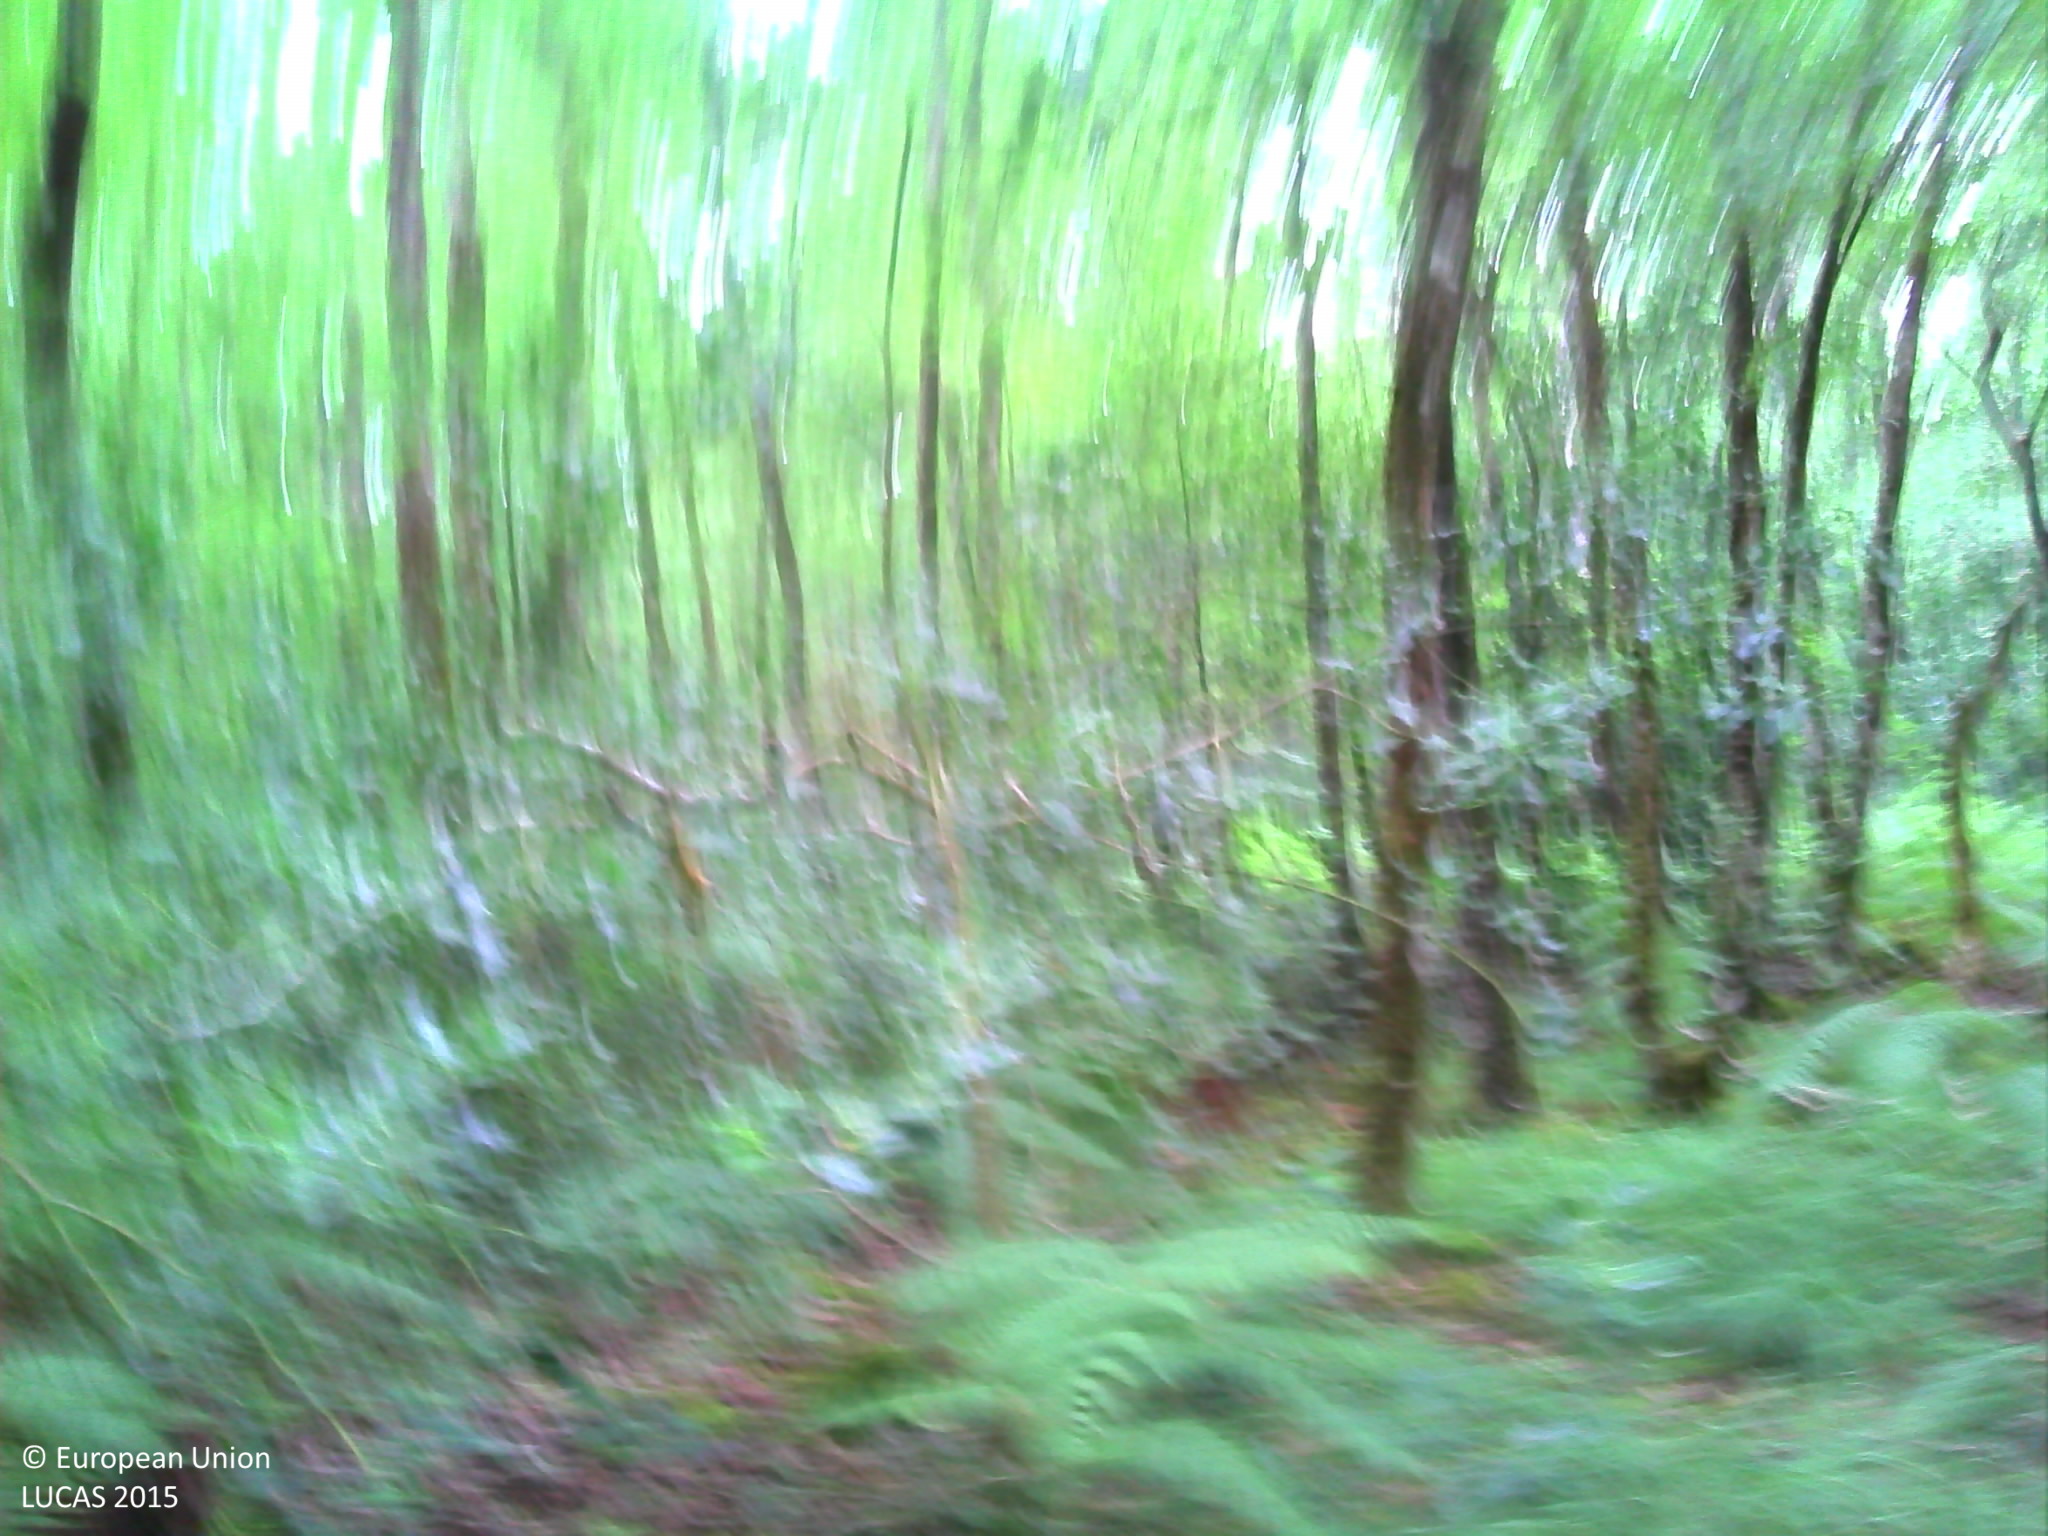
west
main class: Woodland
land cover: Broadleaved woodland
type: acidophilous oak and oak-birch forest
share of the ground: > 75 %
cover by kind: broadleaved forest trees 90 %, coniferous forest trees 5 %, herbaceous plants 5 %
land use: Forestry
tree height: > 5 m
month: July
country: FR
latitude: 47.5324
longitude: -1.8028
